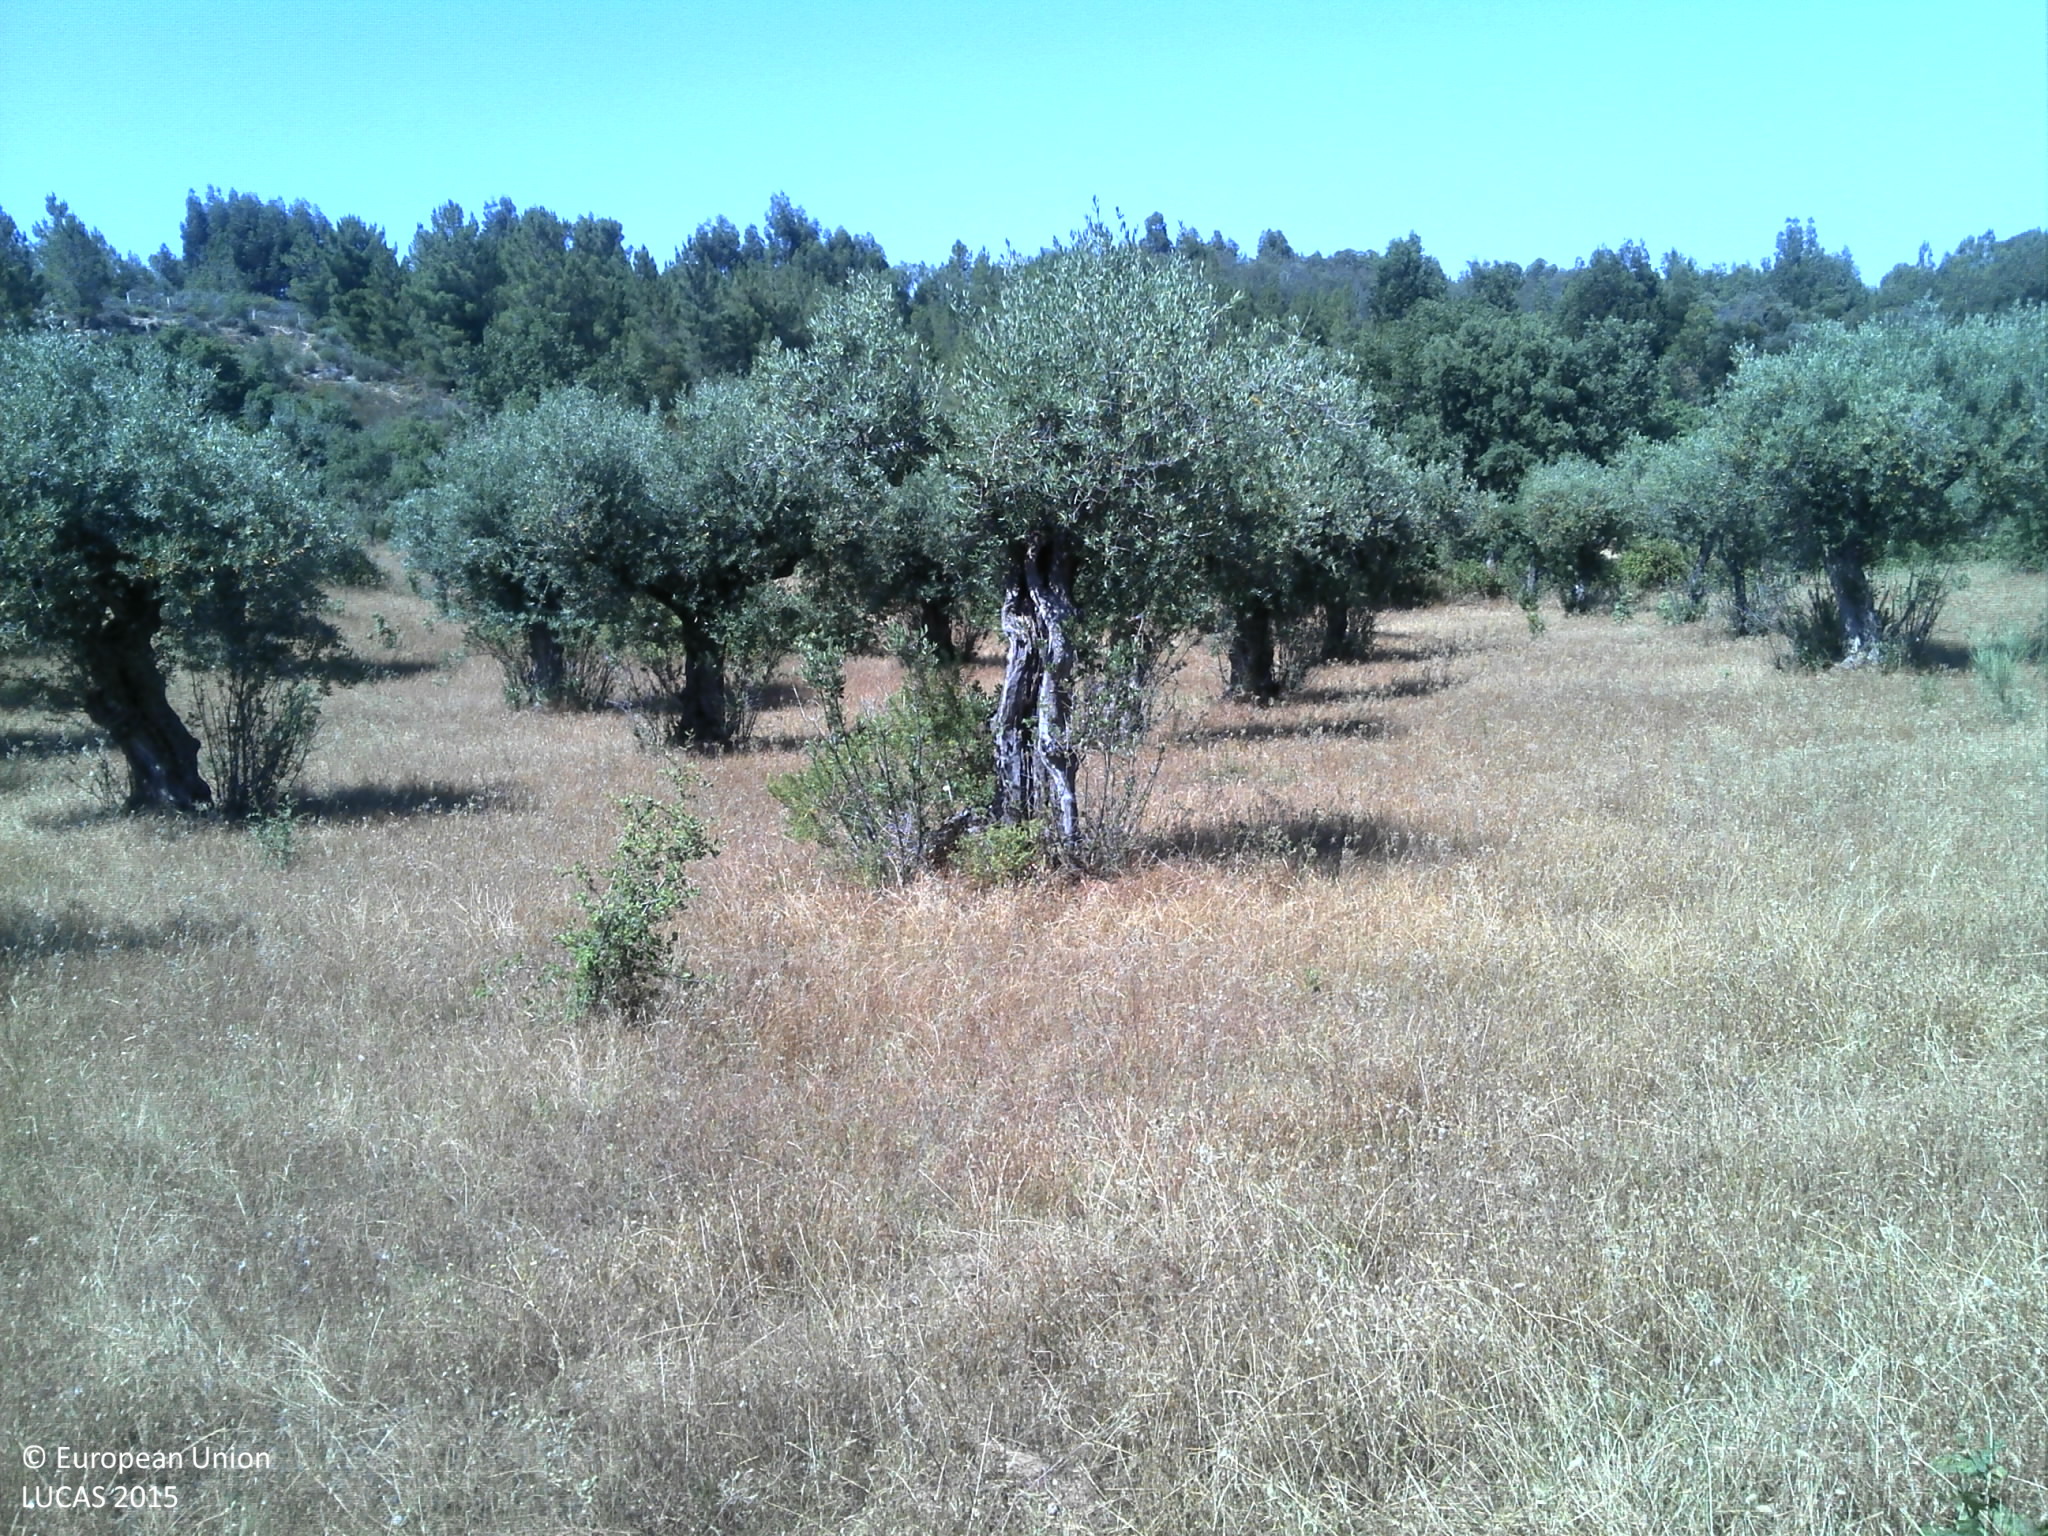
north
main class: Cropland
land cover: Olive groves
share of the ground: 25 - 50 %
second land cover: Grassland without tree/shrub cover
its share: 25 - 50 %
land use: Agriculture (excluding fallow land and kitchen gardens)
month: June
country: PT
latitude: 40.0768
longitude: -7.2294
